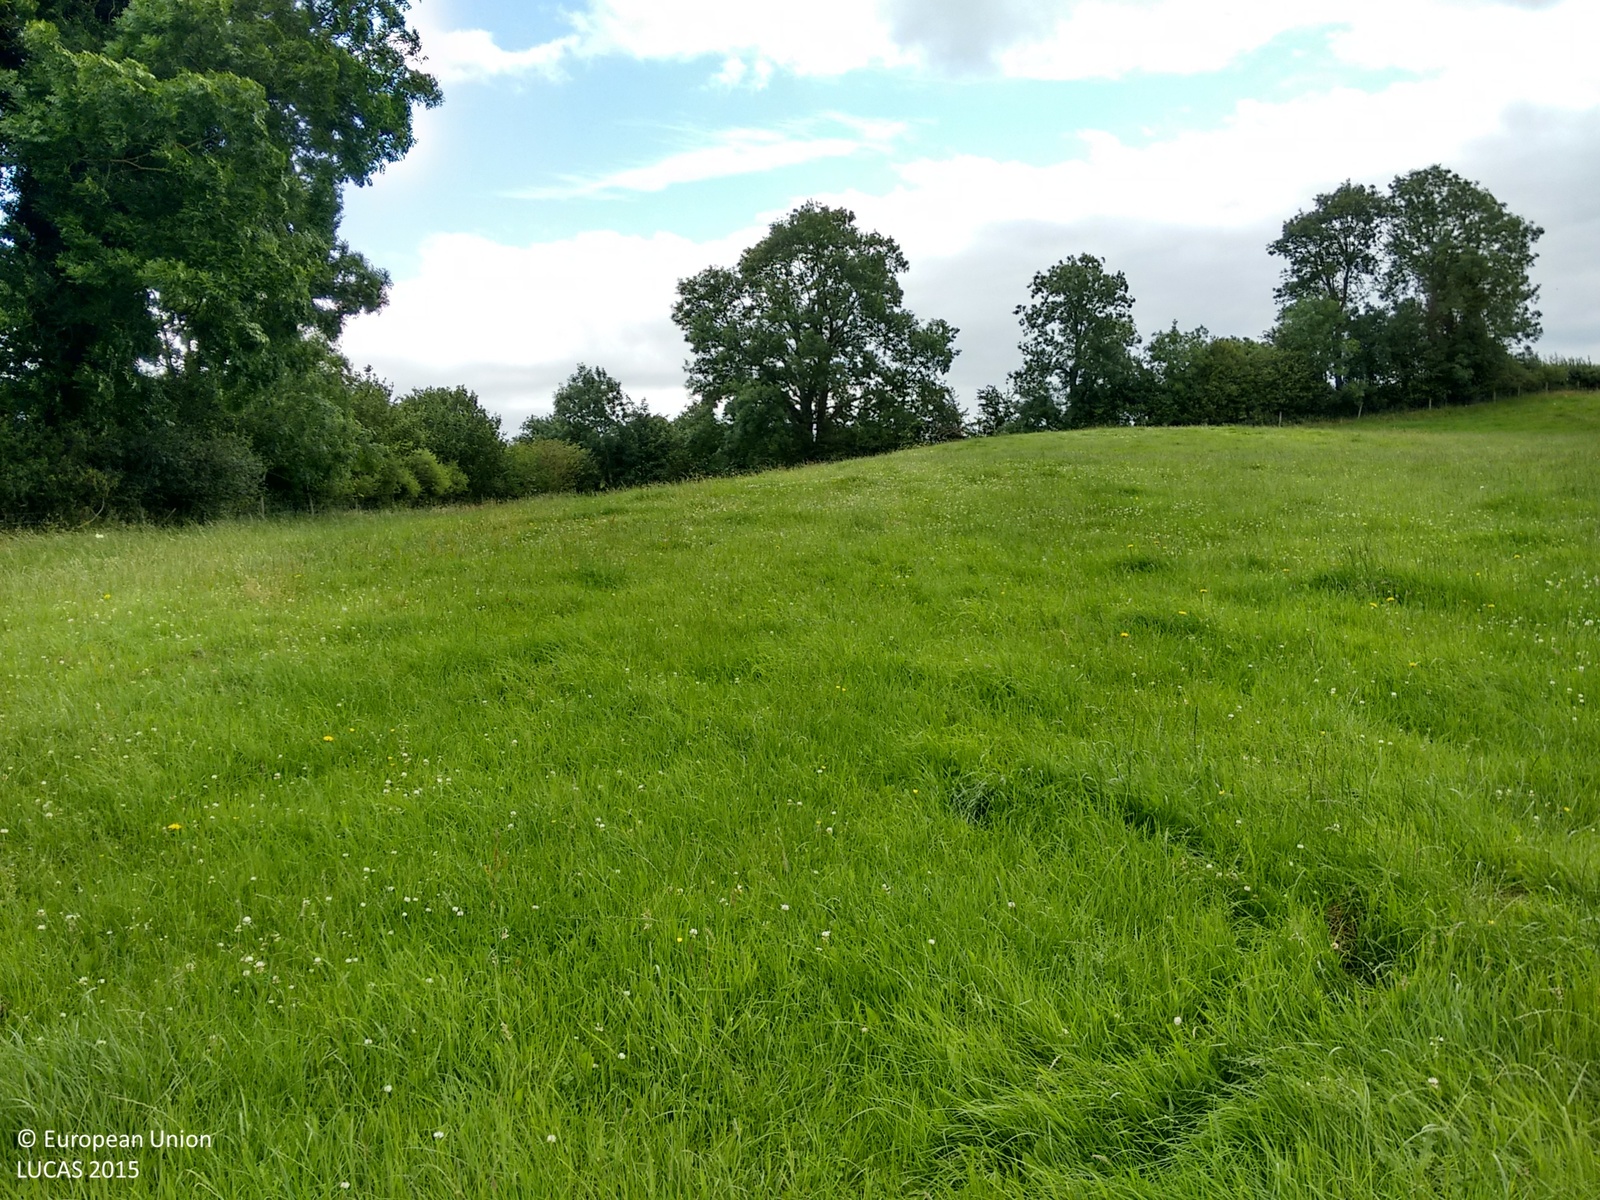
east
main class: Grassland
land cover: Grassland without tree/shrub cover
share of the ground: > 75 %
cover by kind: herbaceous plants 100 %
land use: Agriculture (excluding fallow land and kitchen gardens)
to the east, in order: Grassland without tree/shrub cover; Broadleaved woodland; Fences; Broadleaved woodland; Dry stone walls; Broadleaved woodland; Grassland without tree/shrub cover; Broadleaved woodland; Dry stone walls; Broadleaved woodland; Grassland without tree/shrub cover
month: July
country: IE
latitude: 53.3978
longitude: -8.0279
